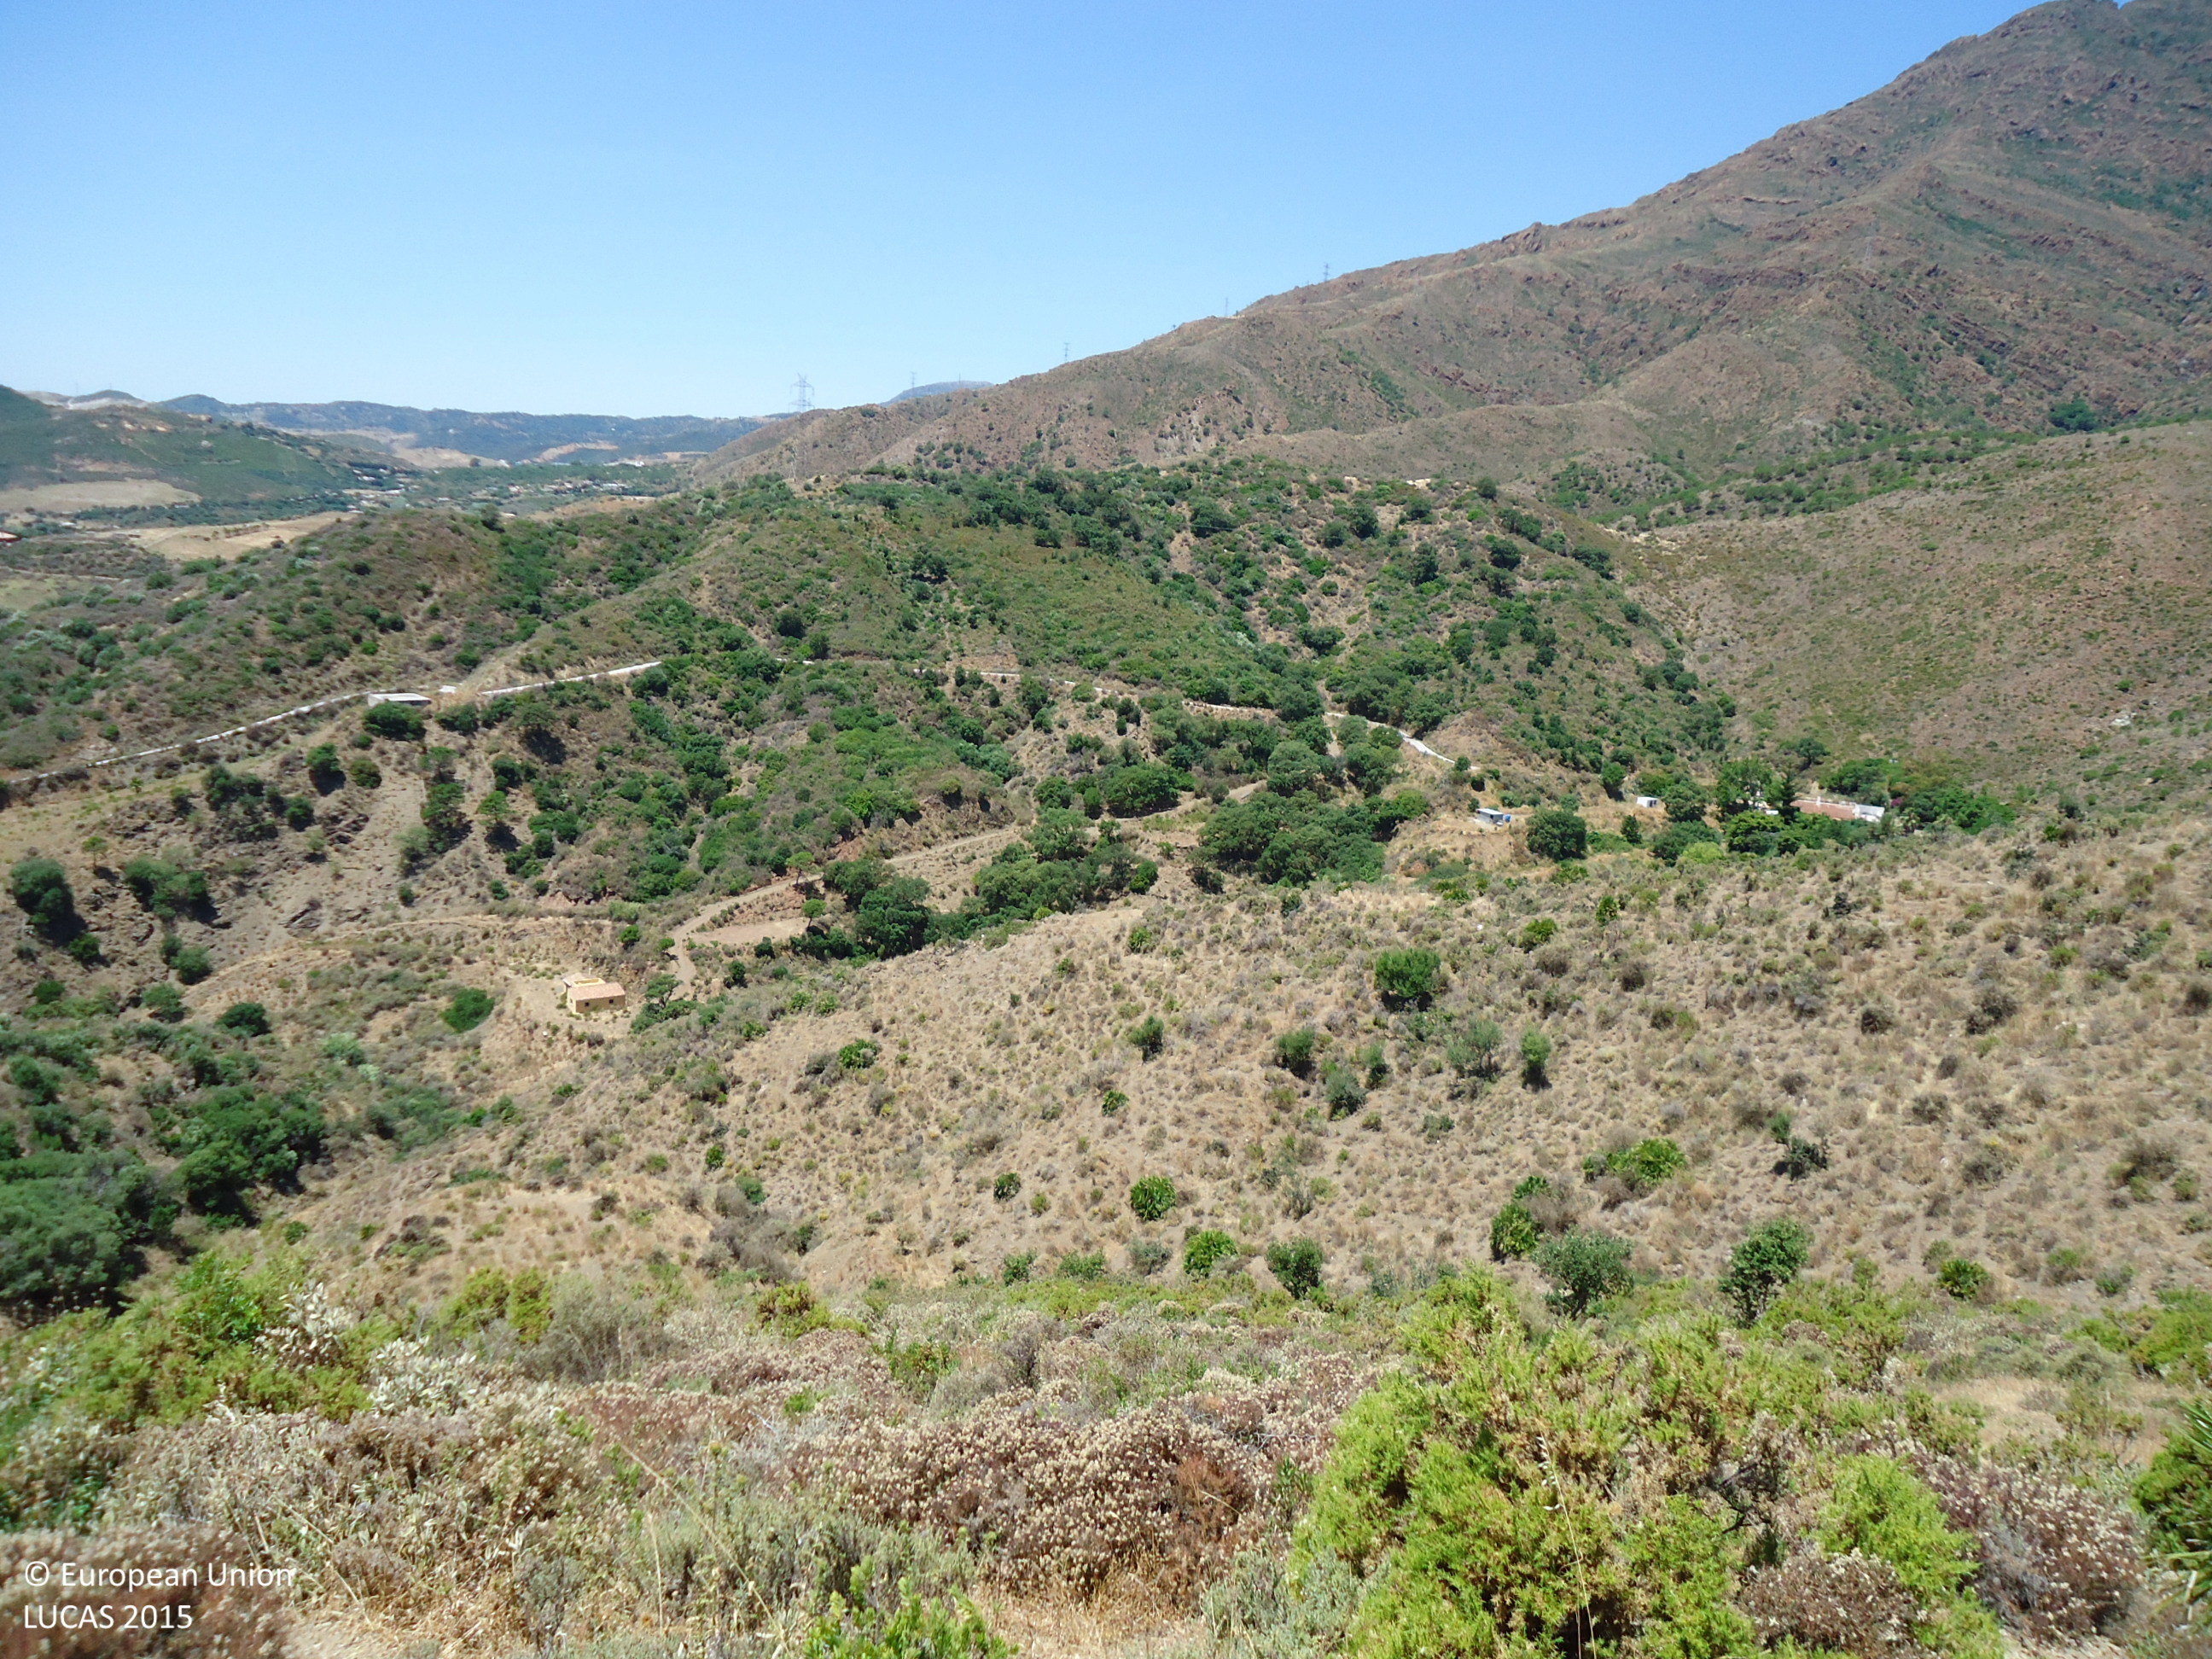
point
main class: Woodland
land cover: Broadleaved woodland
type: broadleaved evergreen forest
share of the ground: > 75 %
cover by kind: shrubs 80 %, broadleaved forest trees 20 %
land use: Semi-natural and natural areas not in use
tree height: < 5 m
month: June
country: ES
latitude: 36.4478
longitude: -5.1783
